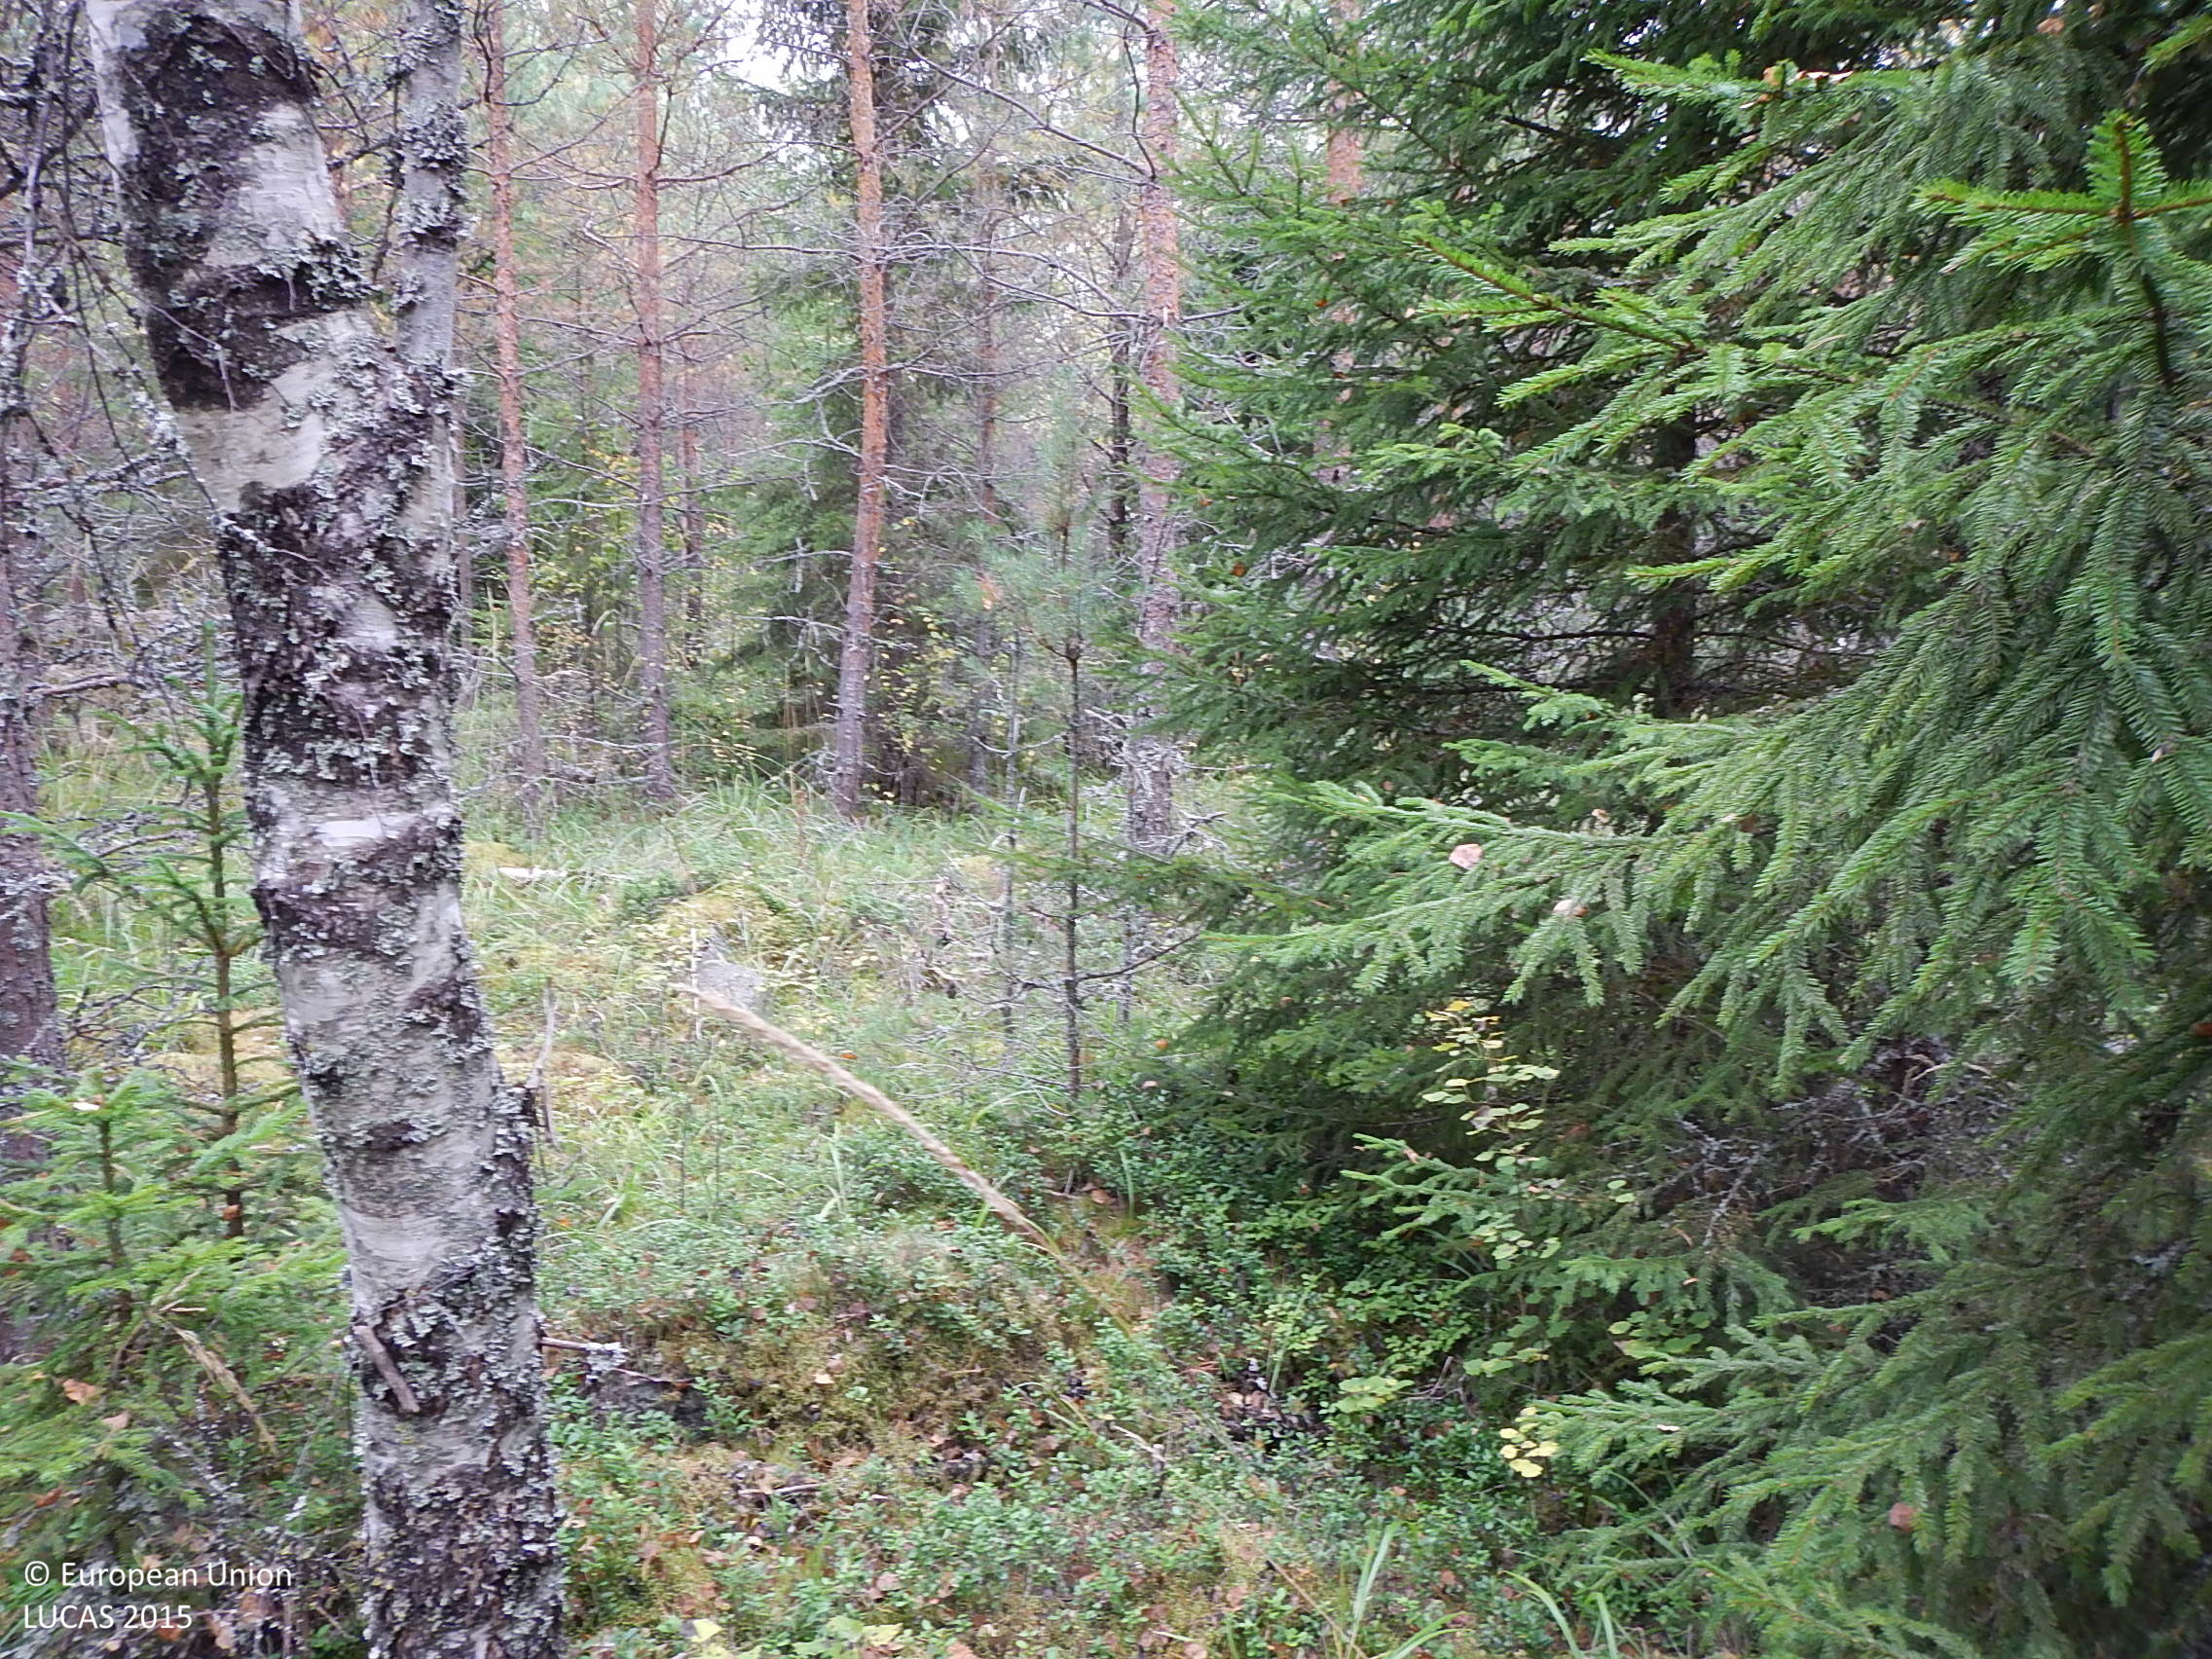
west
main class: Woodland
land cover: Other coniferous woodland
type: boreal forest
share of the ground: > 75 %
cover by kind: coniferous forest trees 60 %, broadleaved forest trees 15 %, shrubs 15 %, herbaceous plants 5 %, lichens and mosses 5 %
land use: Forestry
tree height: > 5 m
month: September
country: FI
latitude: 61.5426
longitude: 22.0404
